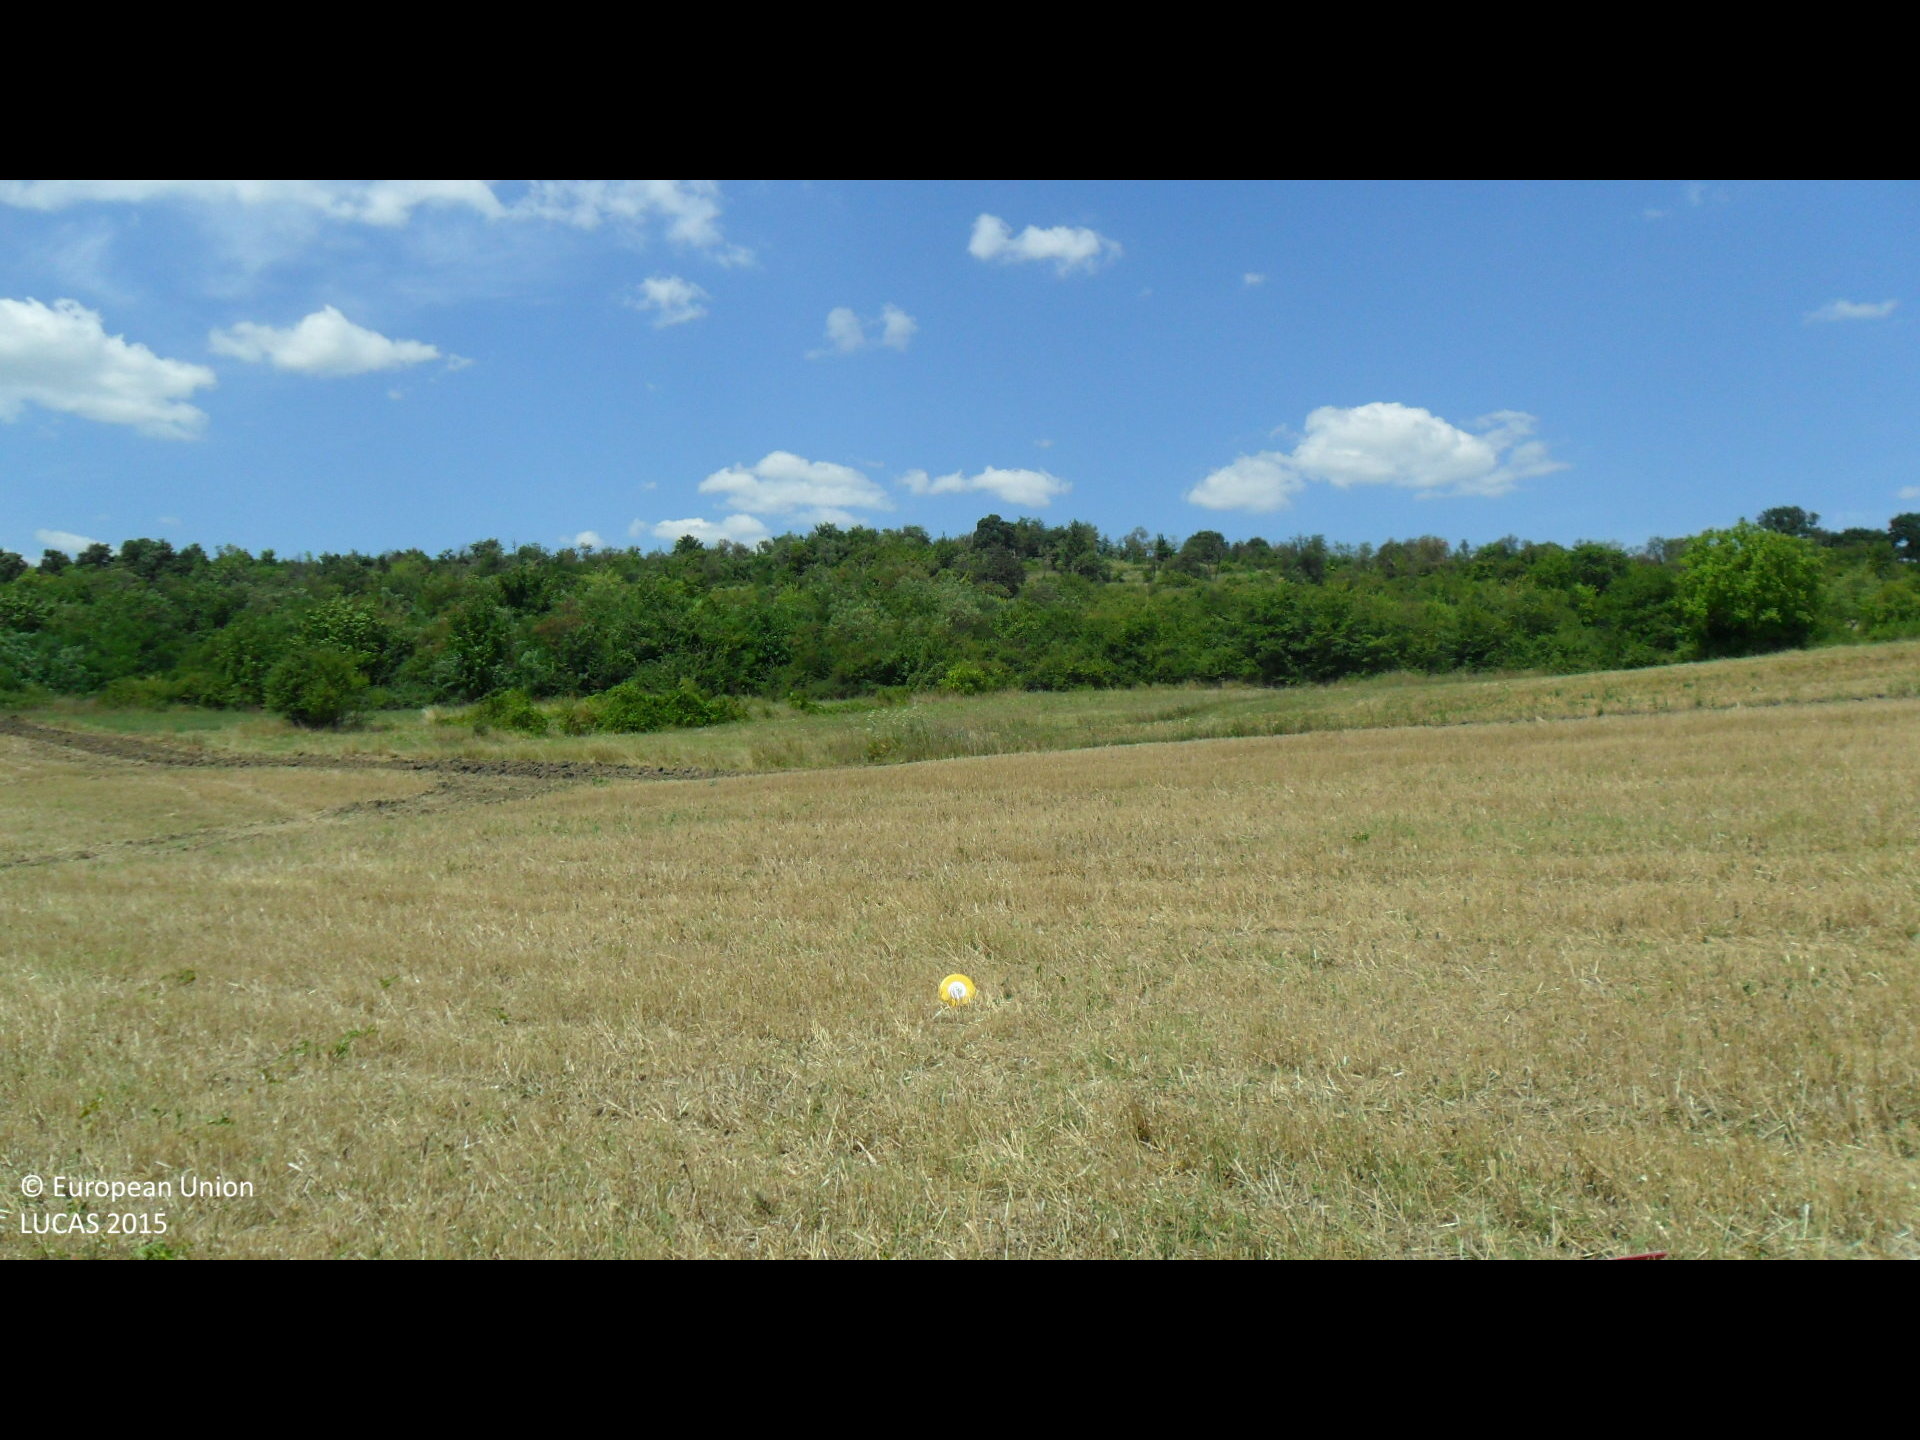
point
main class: Cropland
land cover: Barley
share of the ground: > 75 %
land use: Agriculture (excluding fallow land and kitchen gardens)
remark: Harvested field
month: August
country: BG
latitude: 43.3615
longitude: 26.4261
